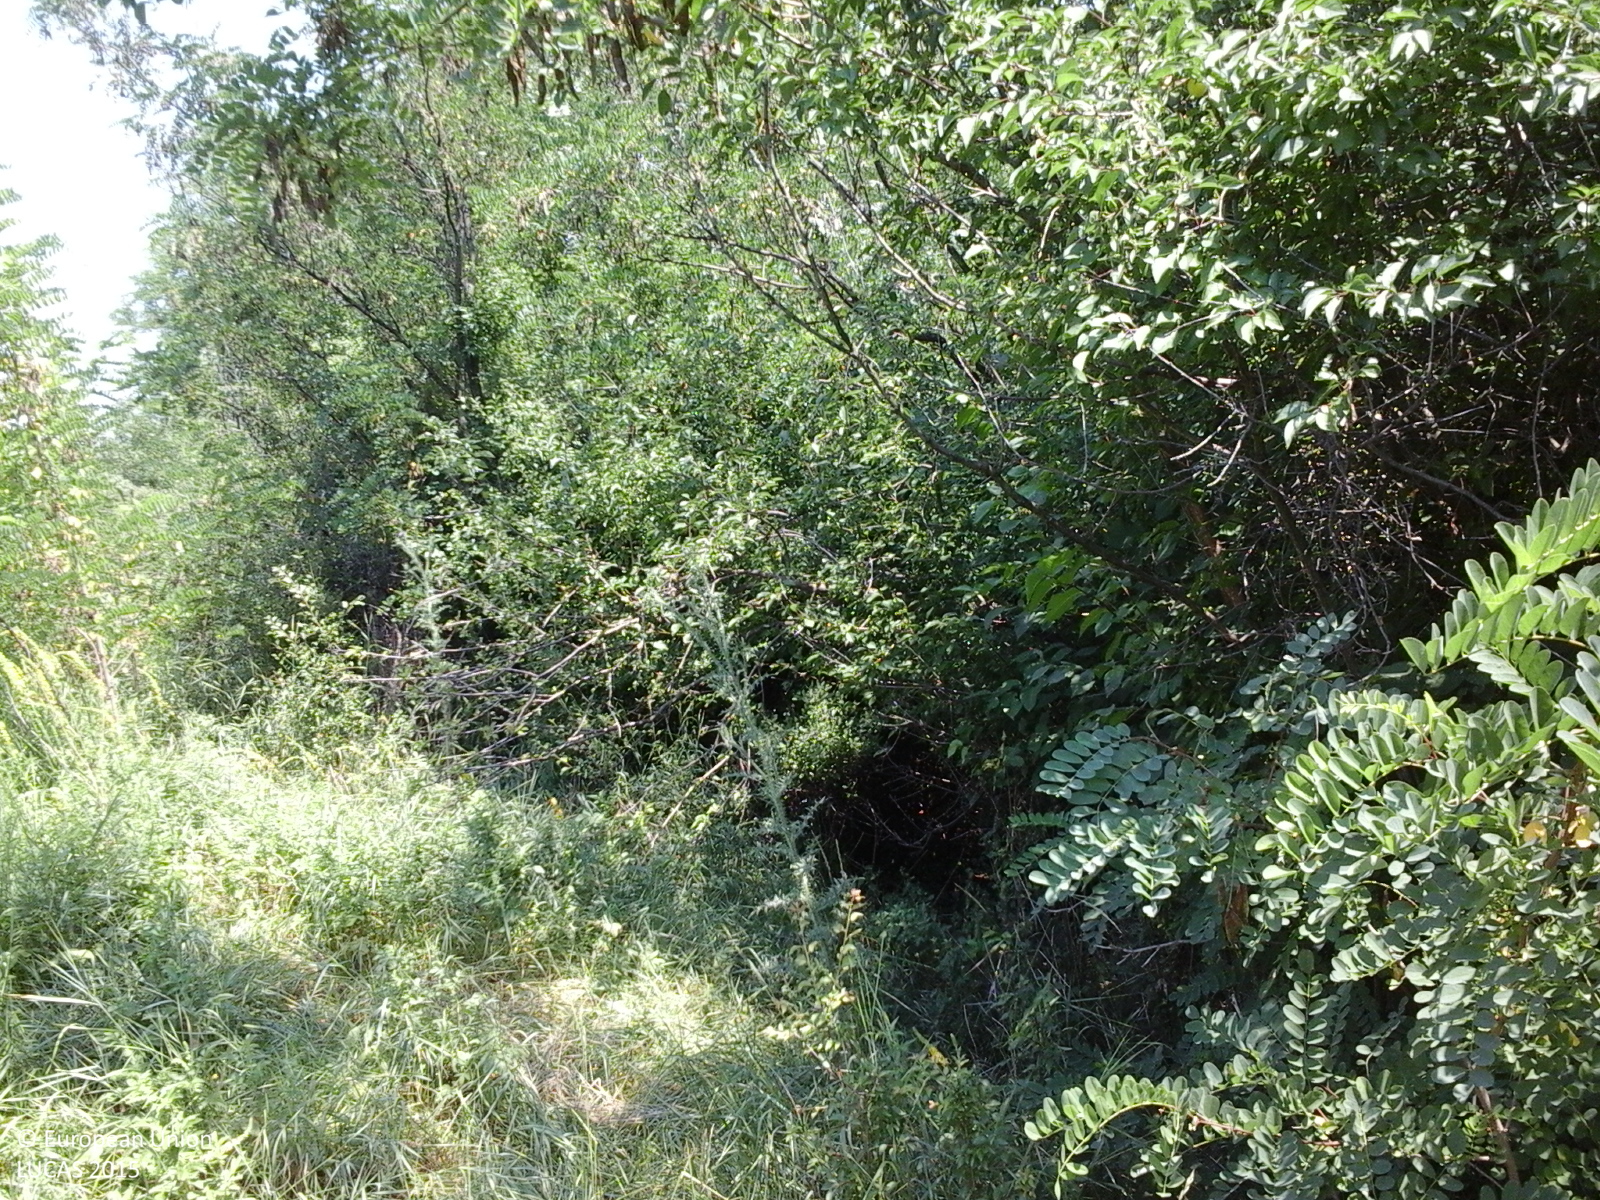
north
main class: Woodland
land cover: Broadleaved woodland
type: thermophilous deciduous forest
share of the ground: > 75 %
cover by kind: broadleaved forest trees 85 %, herbaceous plants 10 %, shrubs 5 %
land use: Forestry
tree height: > 5 m
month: July
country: RO
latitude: 44.6881
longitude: 24.5718
